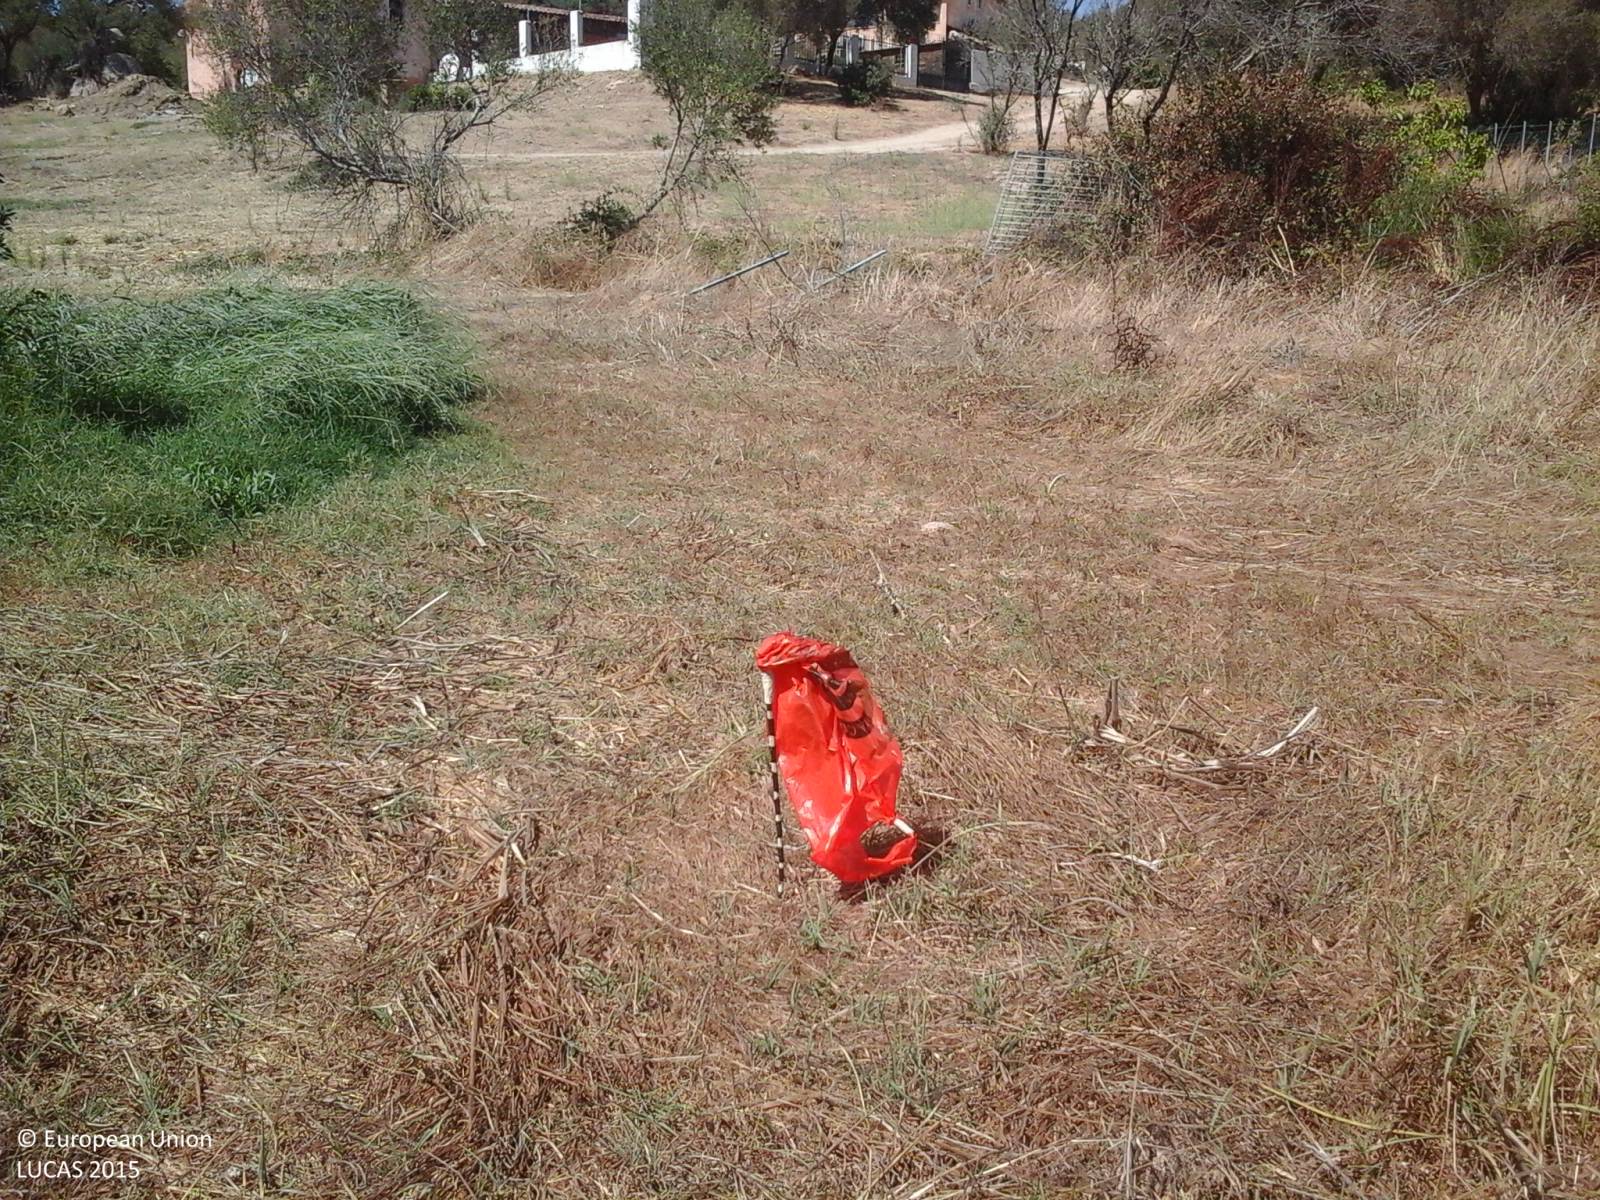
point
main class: Grassland
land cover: Grassland without tree/shrub cover
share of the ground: > 75 %
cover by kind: herbaceous plants 95 %, unconsolidated bare surface 5 %
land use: Agriculture (excluding fallow land and kitchen gardens)
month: August
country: IT
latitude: 41.0256
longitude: 9.4199
